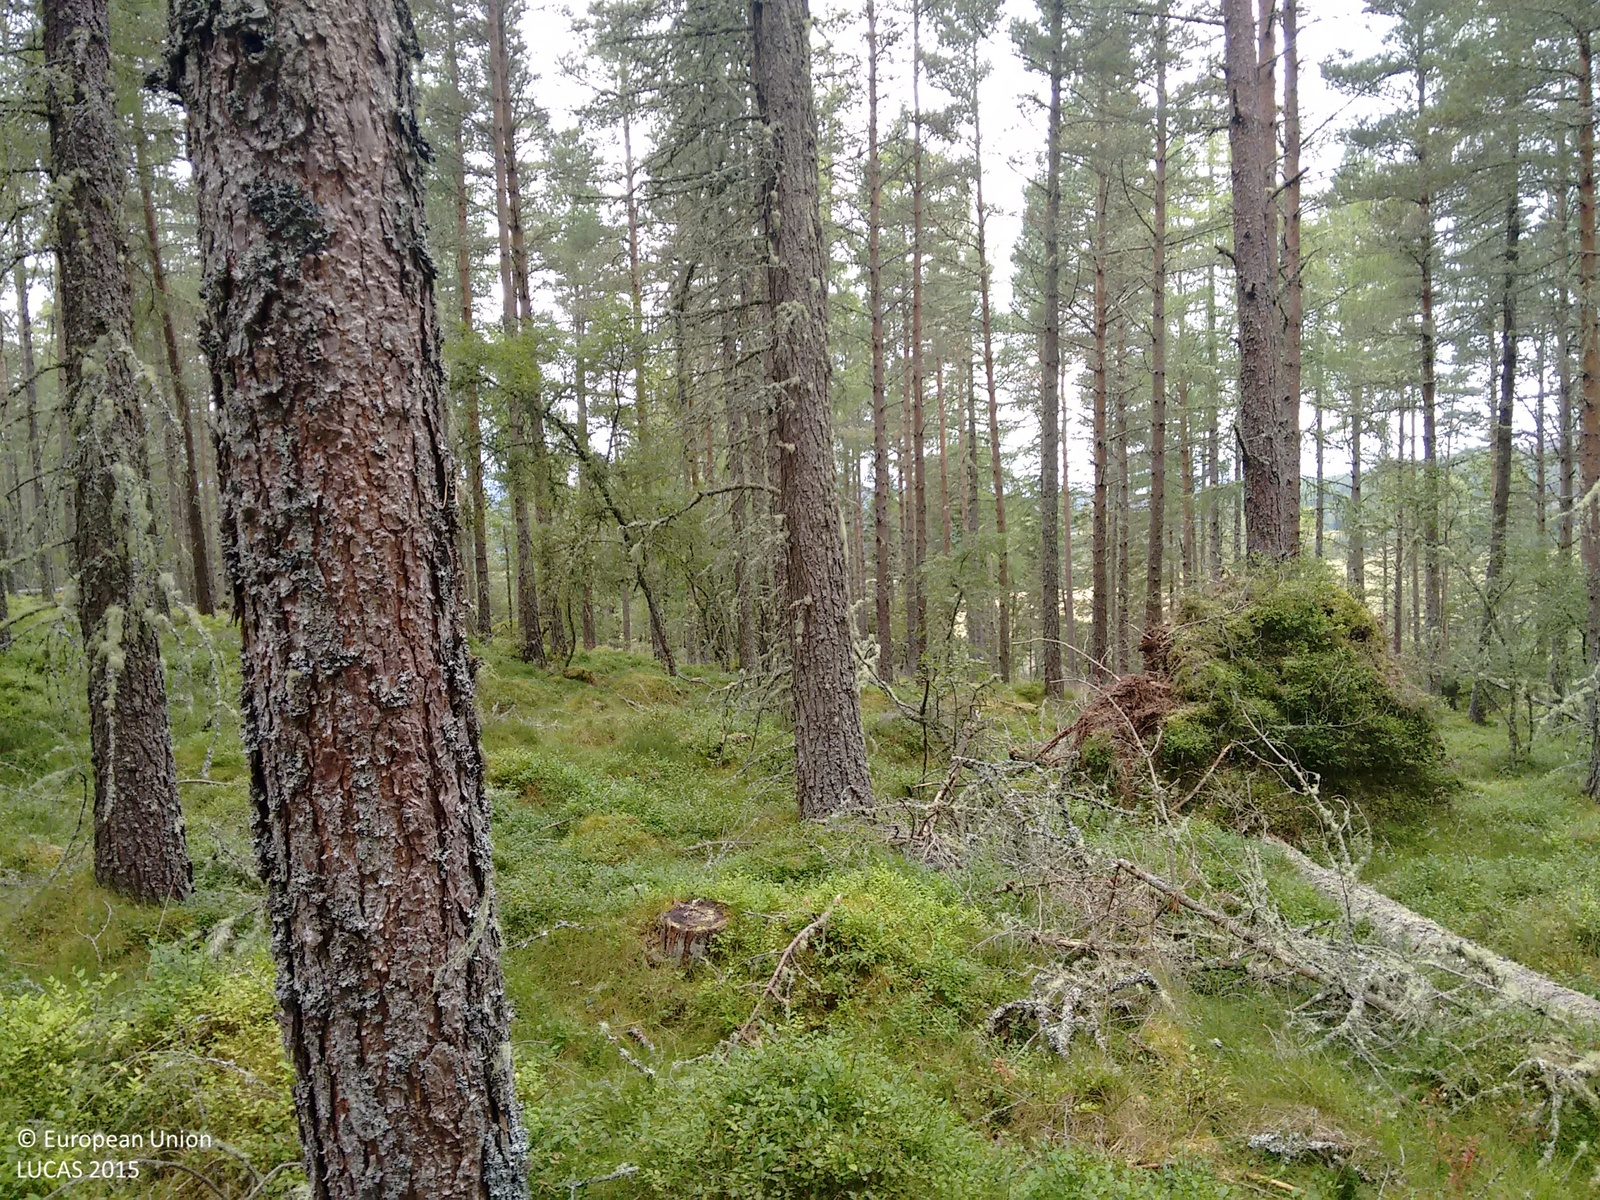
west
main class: Woodland
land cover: Pine dominated coniferous woodland
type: hemiboreal forest and nemoral coniferous forest and mixed broadleaved-coniferous forest
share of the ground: > 75 %
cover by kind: coniferous forest trees 80 %, shrubs 15 %, herbaceous plants 5 %
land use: Forestry
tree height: > 5 m
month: September
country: GB
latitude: 57.7407
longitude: -4.3135
